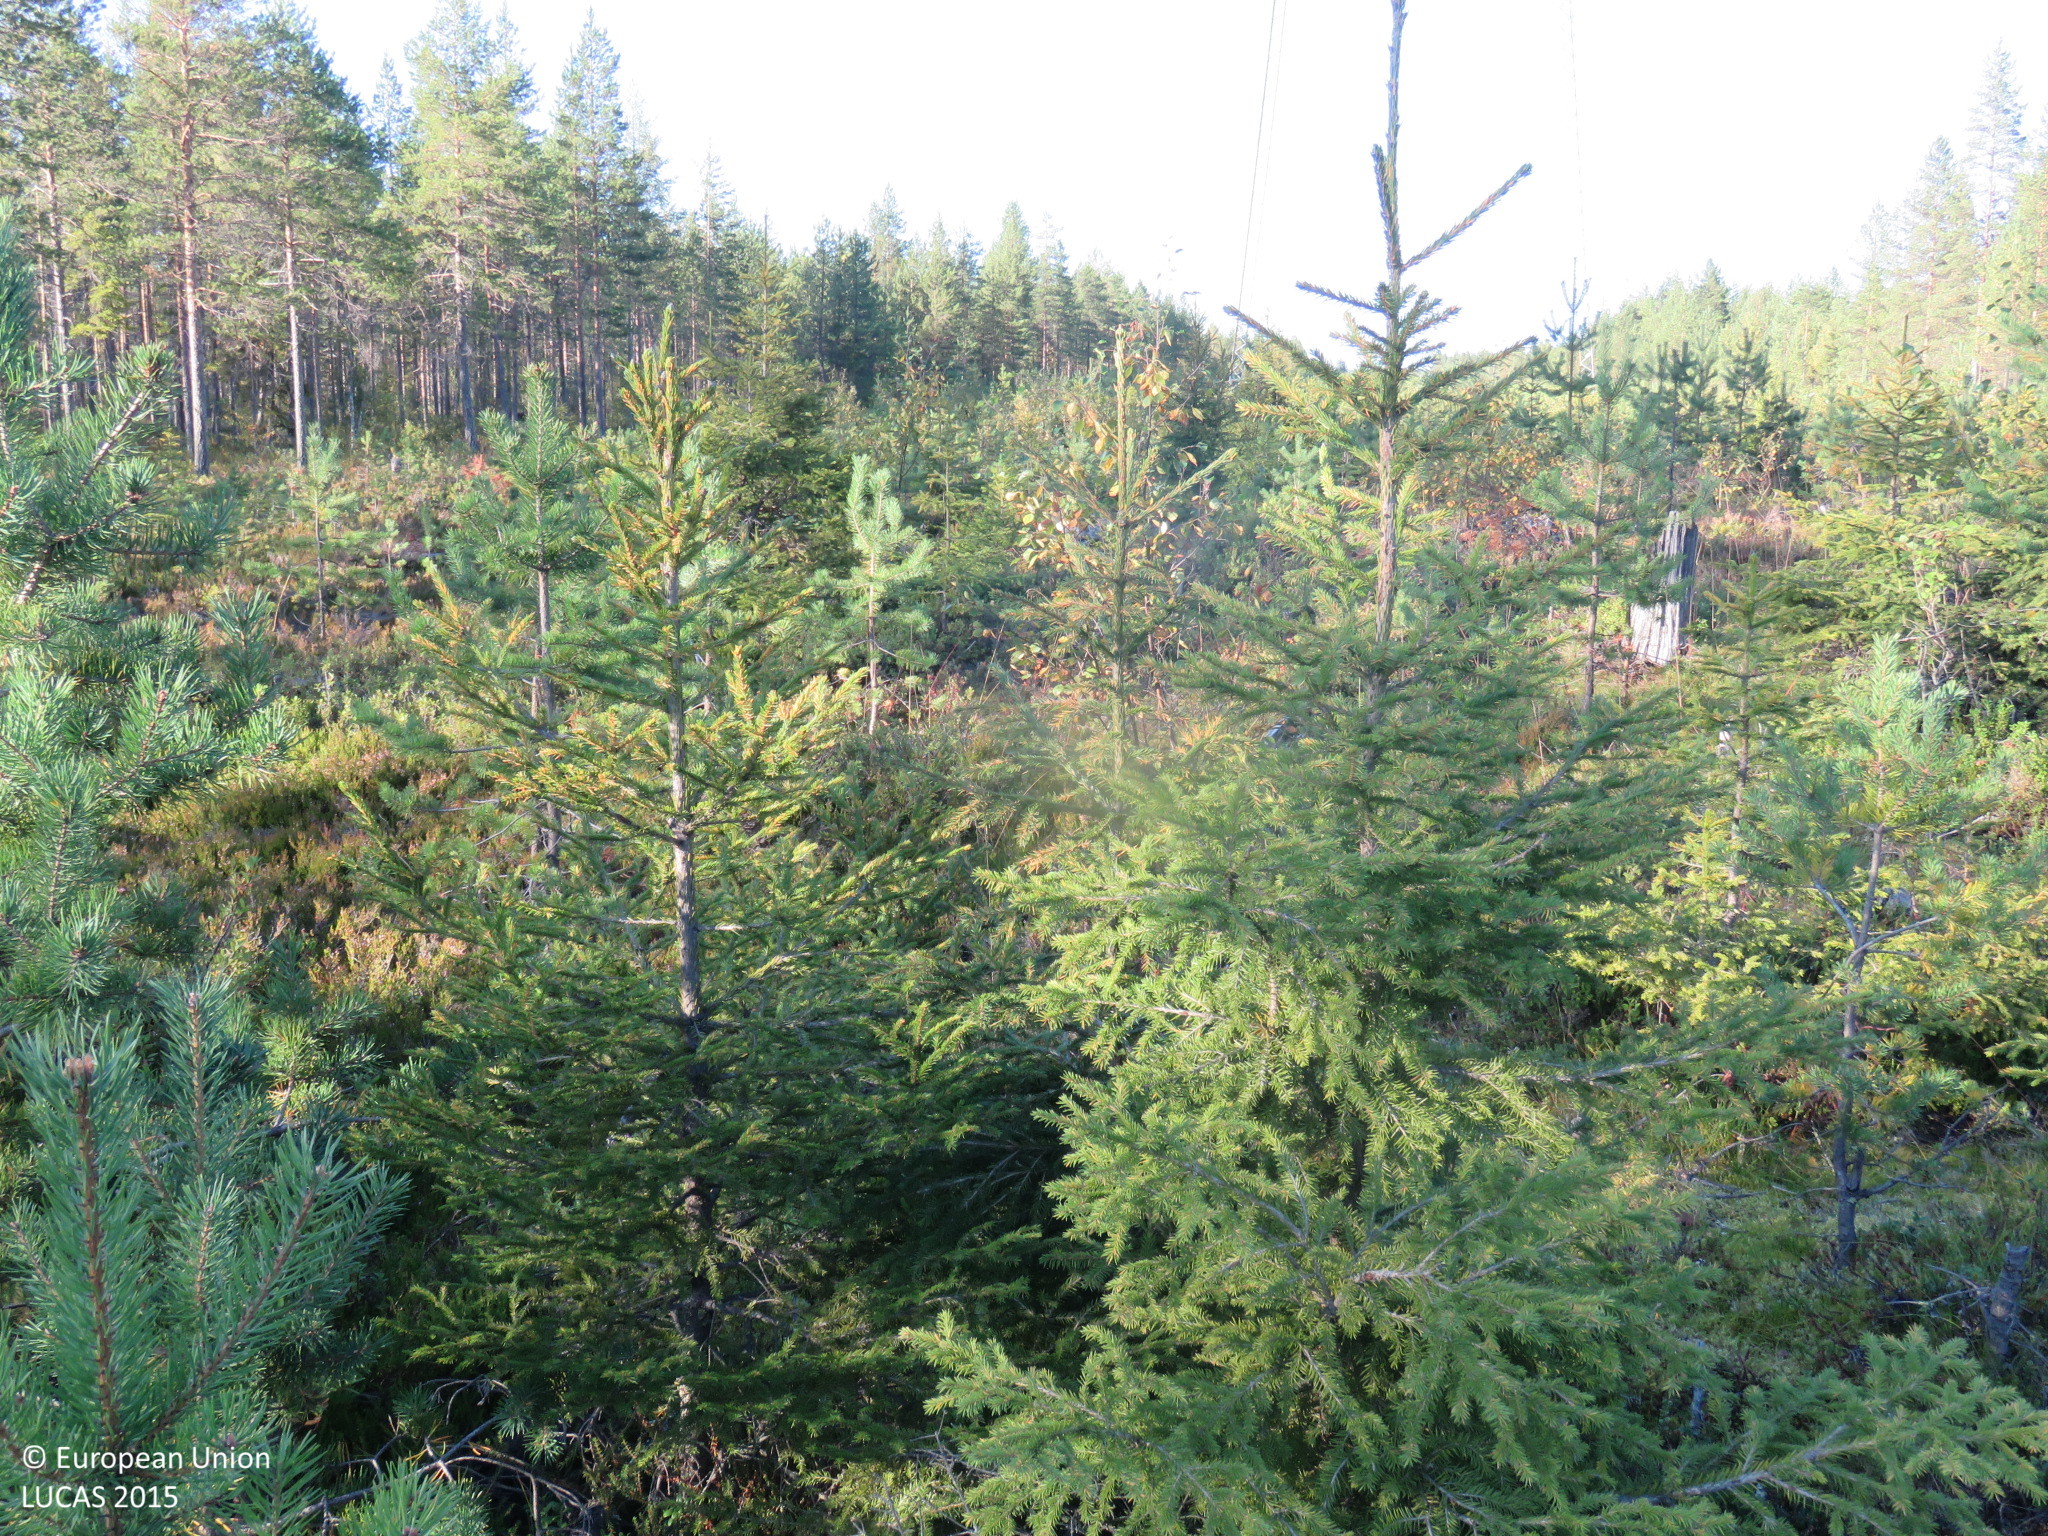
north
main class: Artificial land
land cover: Other artificial areas
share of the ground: > 75 %
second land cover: Other coniferous woodland
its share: 25 - 50 %
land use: Electricity, gas and thermal power distribution
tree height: < 5 m
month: August
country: FI
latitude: 65.3120
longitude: 26.0789
